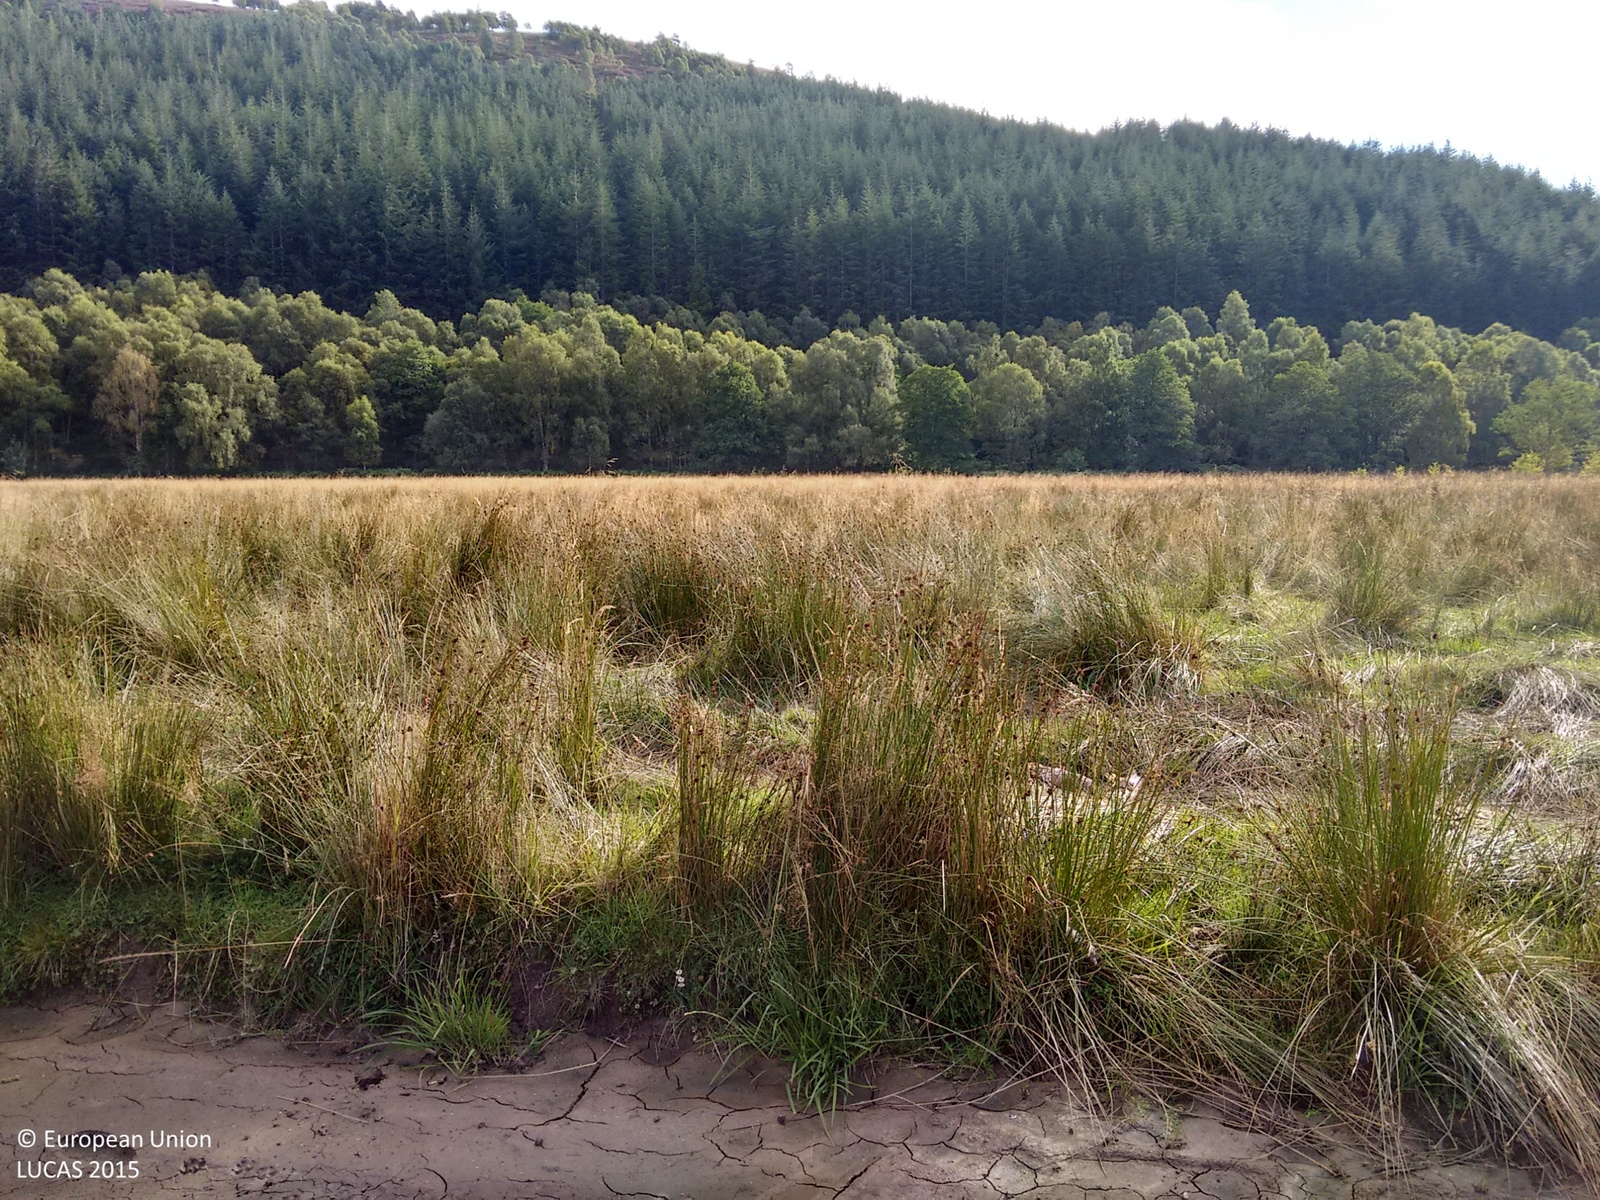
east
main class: Woodland
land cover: Broadleaved woodland
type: floodplain forest
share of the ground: > 75 %
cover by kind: broadleaved forest trees 100 %
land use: Semi-natural and natural areas not in use
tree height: > 5 m
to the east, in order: Broadleaved woodland; Inland fresh running water; Abandoned hedges; Tracks; Grassland without tree/shrub cover; Ditches and canals; Broadleaved woodland; Tracks; Broadleaved woodland
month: September
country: GB
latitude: 57.6095
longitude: -4.6726
